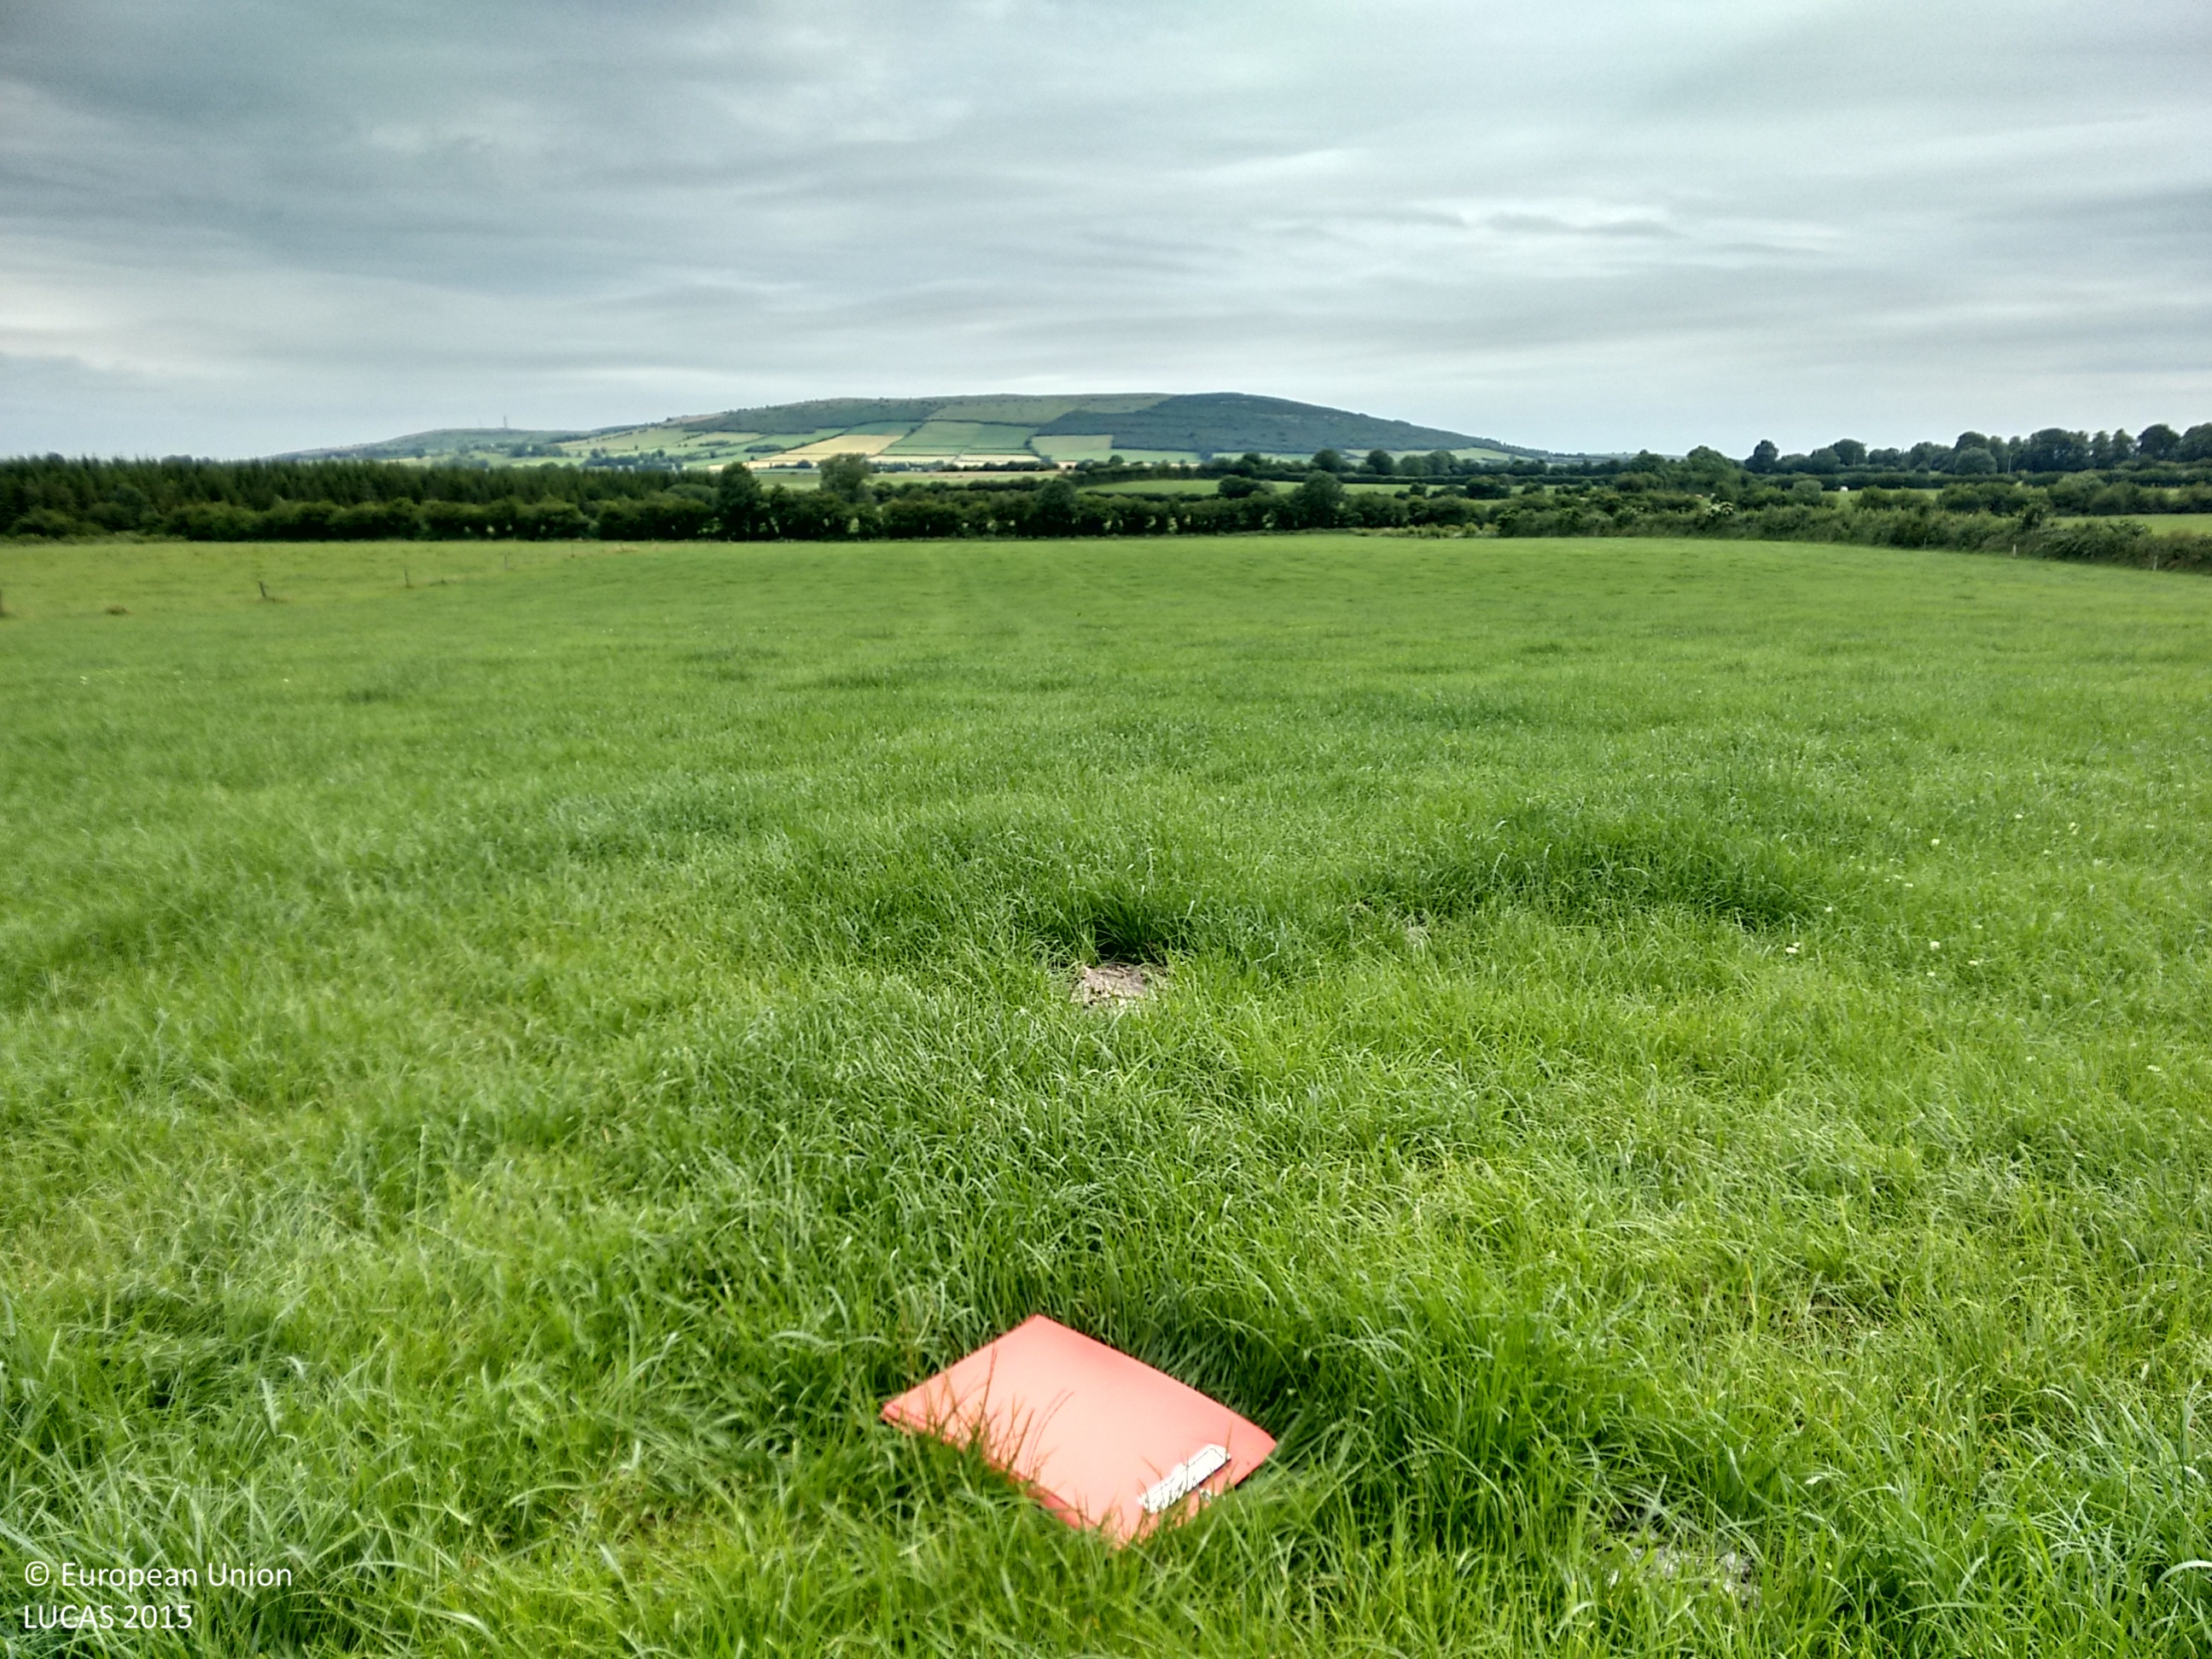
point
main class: Grassland
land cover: Grassland without tree/shrub cover
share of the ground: > 75 %
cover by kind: herbaceous plants 100 %
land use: Agriculture (excluding fallow land and kitchen gardens)
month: July
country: IE
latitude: 52.7127
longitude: -7.5535
